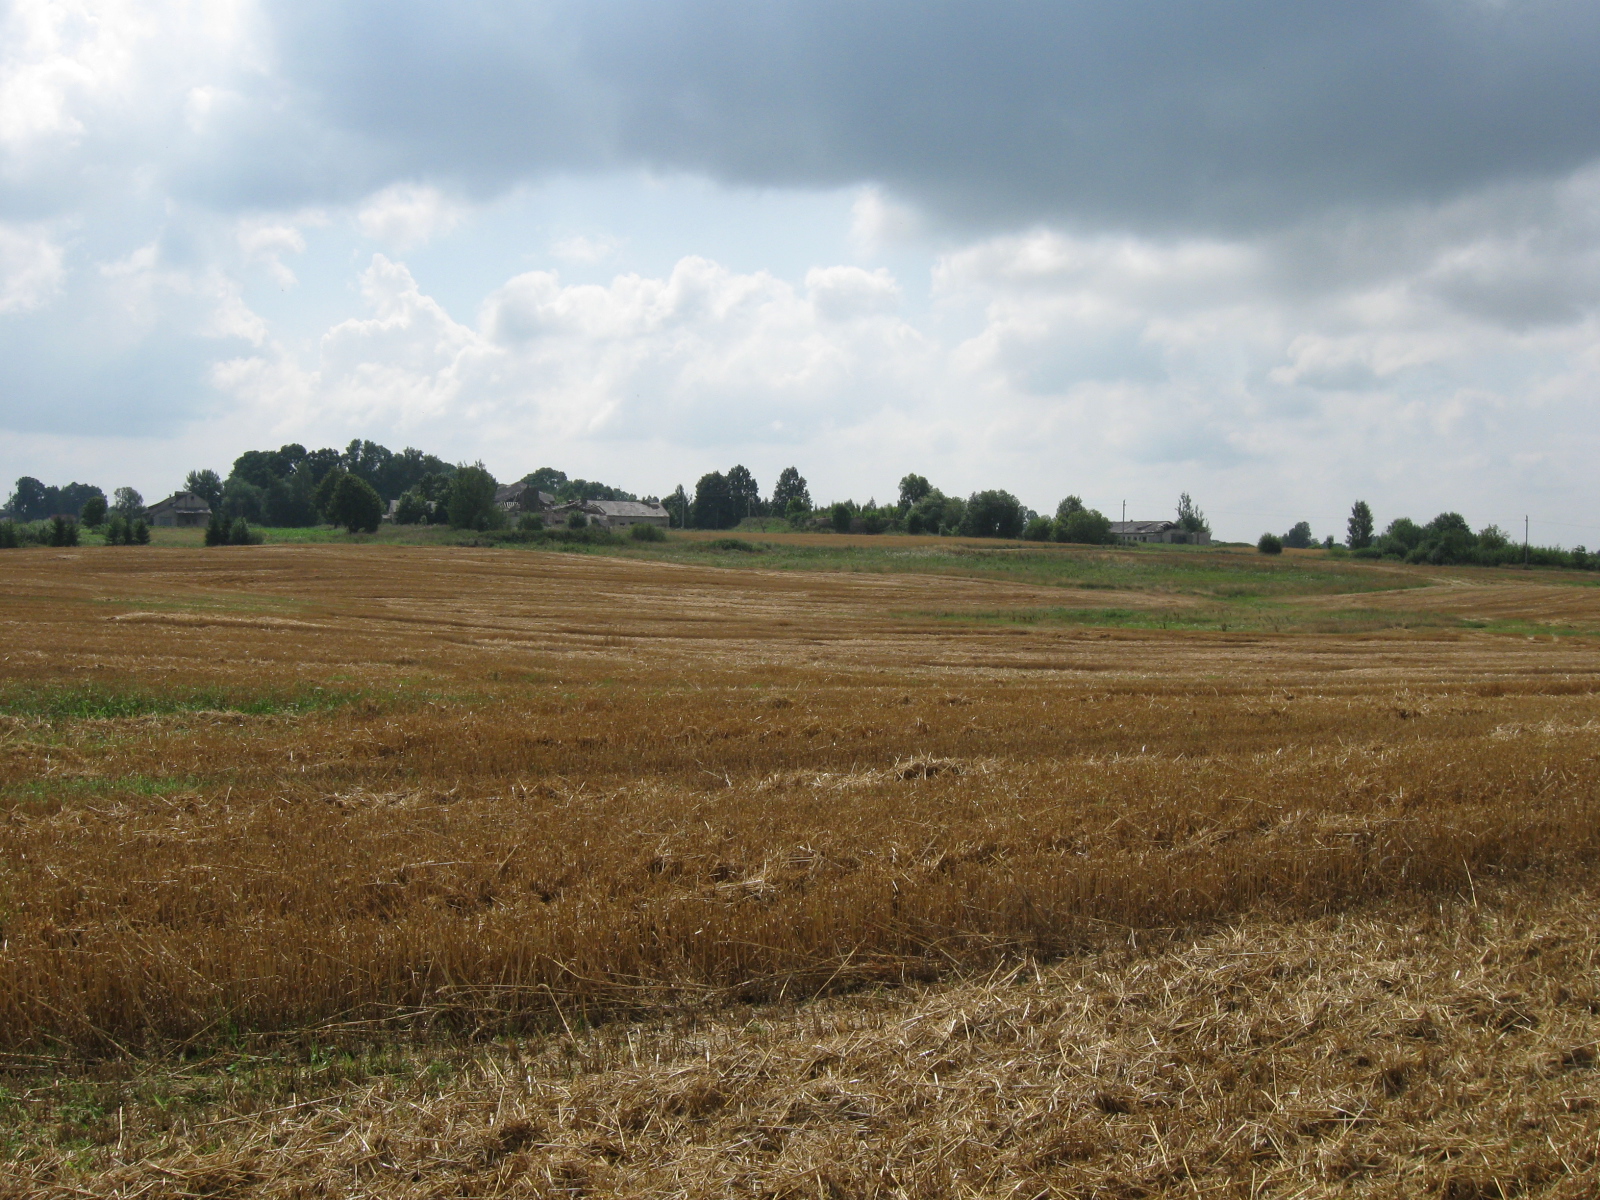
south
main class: Cropland
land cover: Common wheat
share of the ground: > 75 %
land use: Agriculture (excluding fallow land and kitchen gardens)
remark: Harvested field
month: August
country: LT
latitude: 54.7034
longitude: 23.6635
